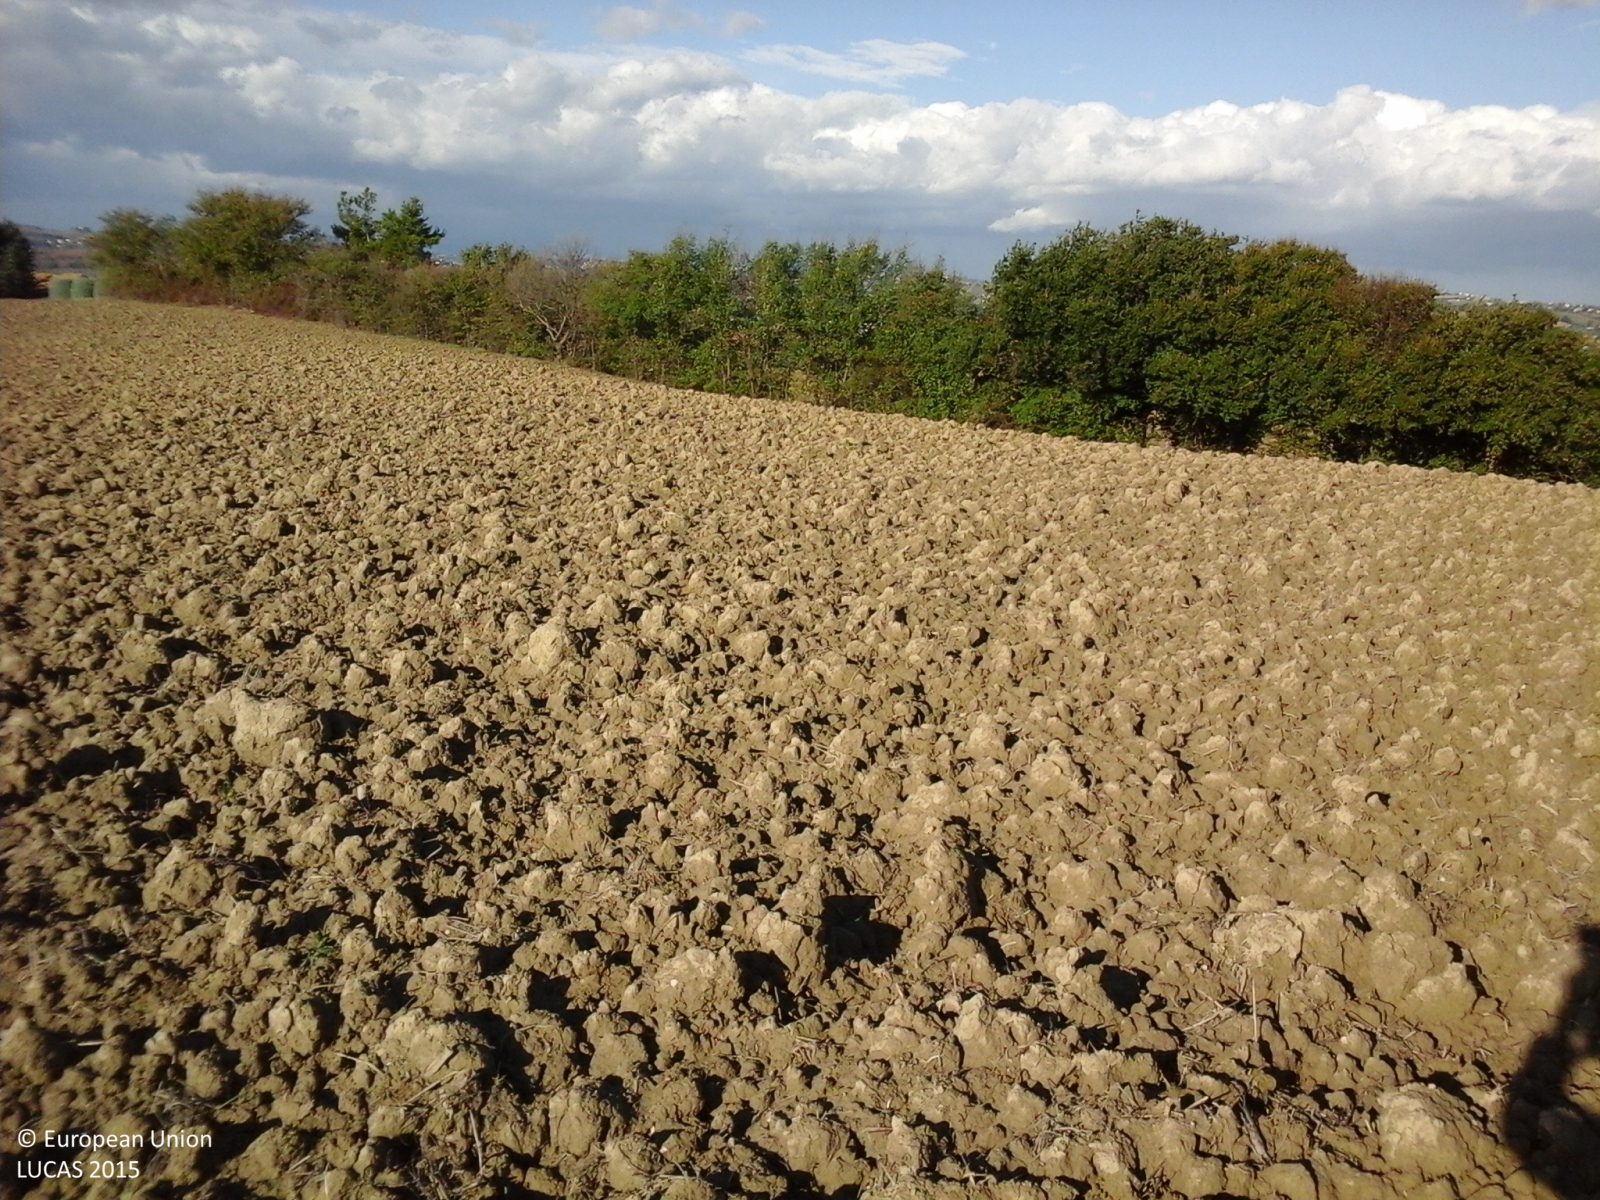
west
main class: Cropland
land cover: Durum wheat
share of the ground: < 10 %
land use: Agriculture (excluding fallow land and kitchen gardens)
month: October
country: IT
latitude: 43.6520
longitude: 13.1788
